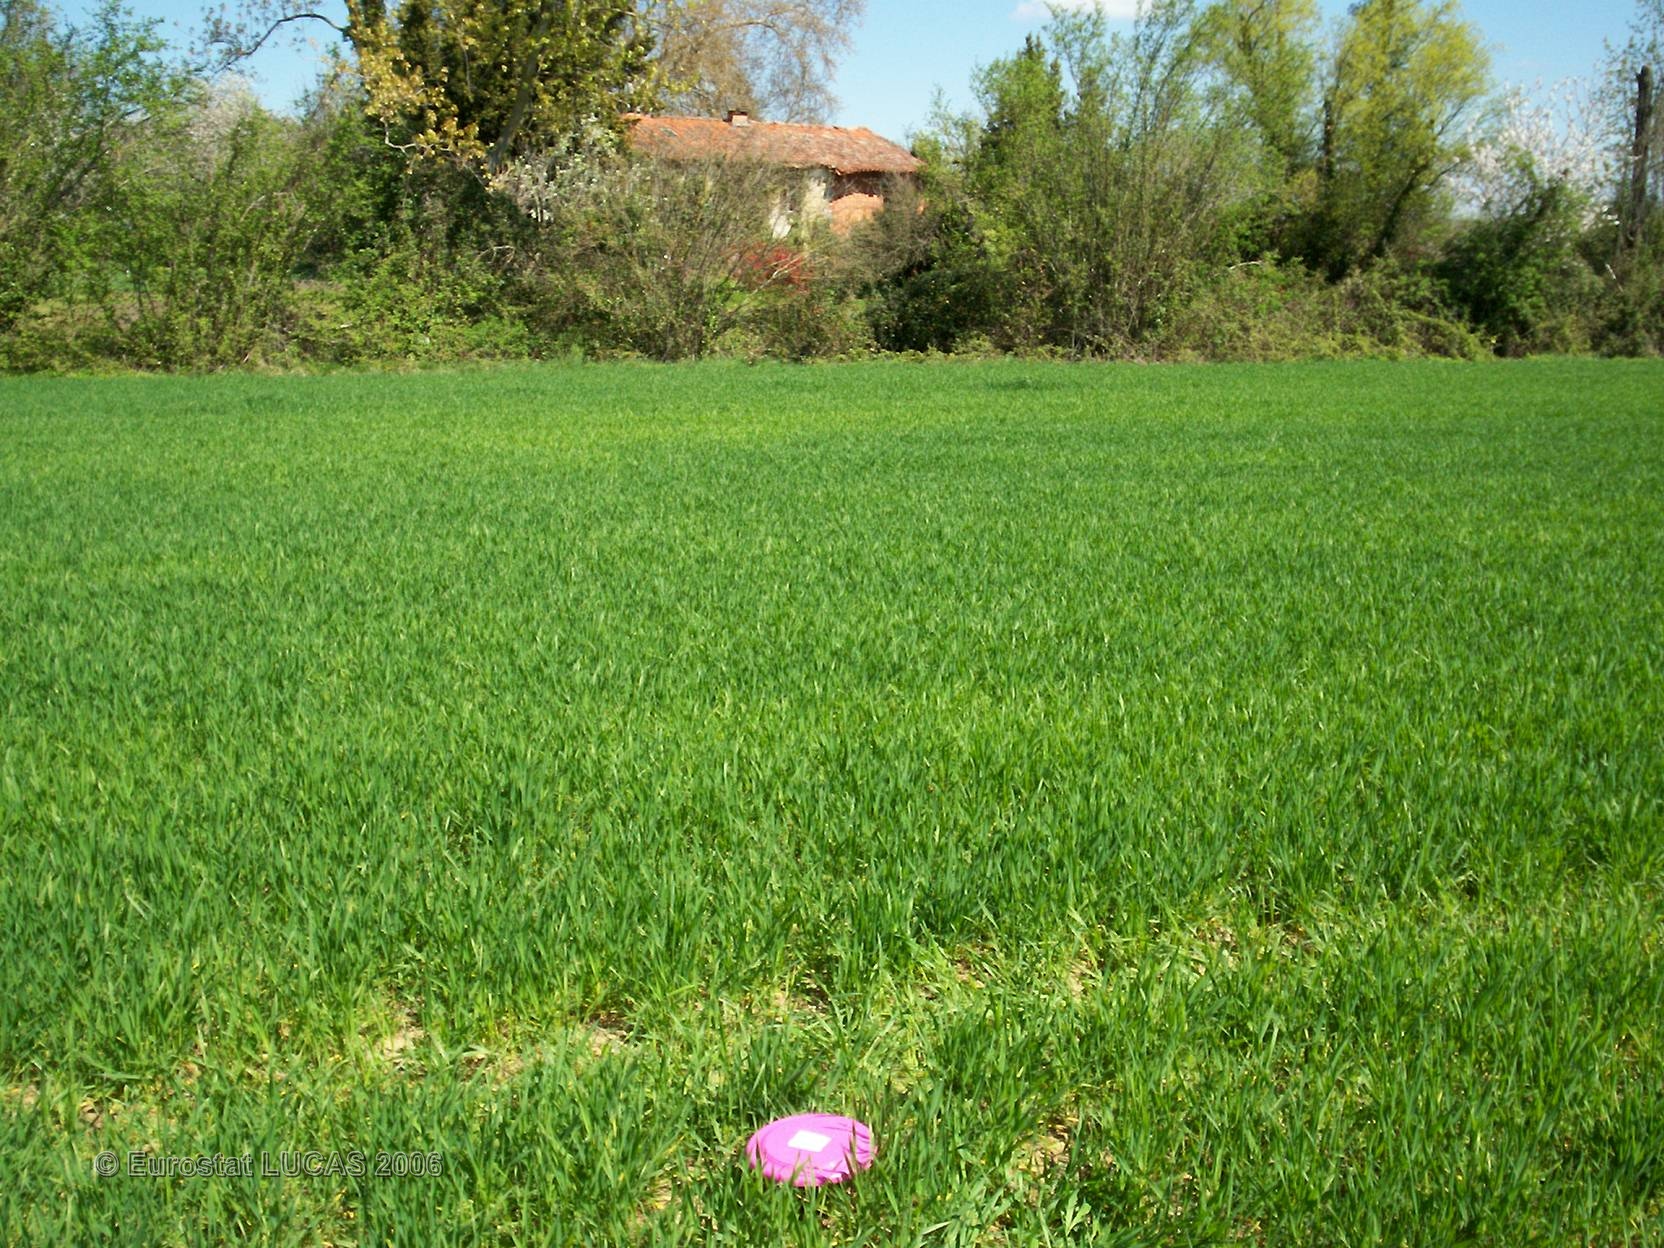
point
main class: Cropland
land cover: Barley
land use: Agriculture (excluding fallow land and kitchen gardens)
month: April
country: FR
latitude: 43.5537
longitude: 2.0211
